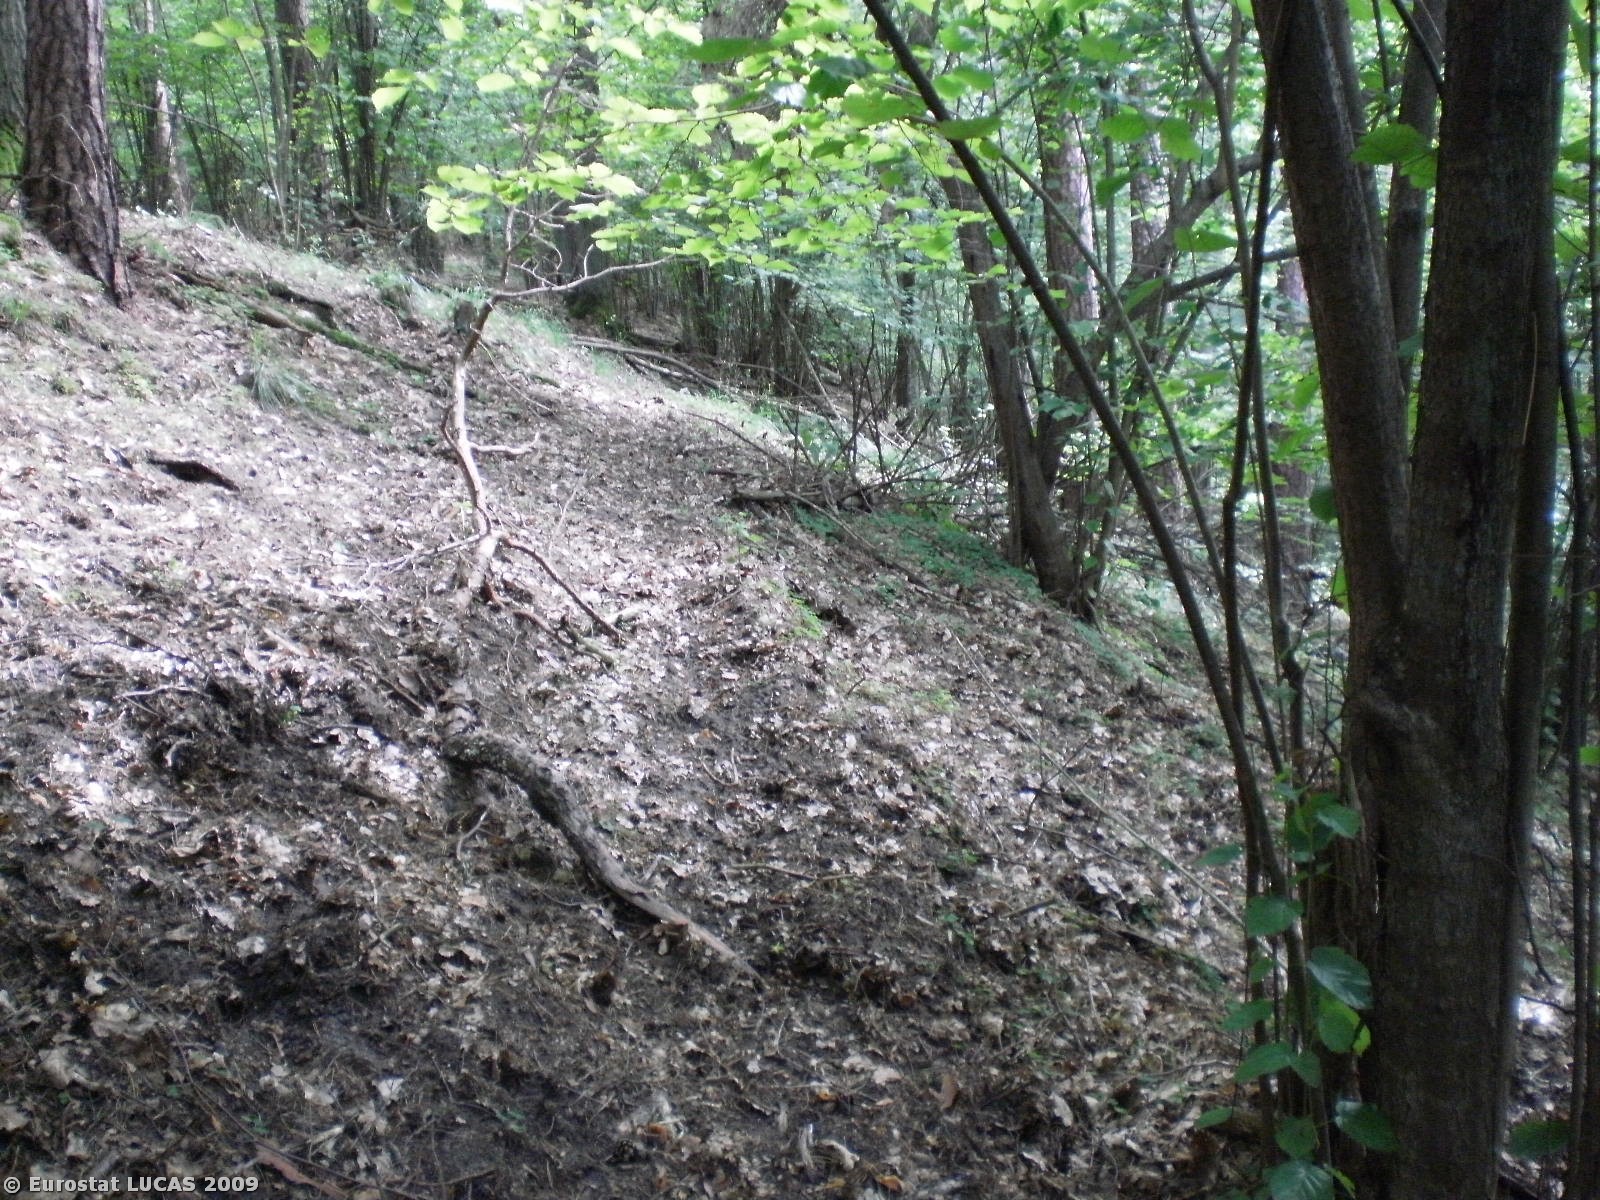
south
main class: Woodland
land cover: Mixed woodland
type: hemiboreal forest and nemoral coniferous forest and mixed broadleaved-coniferous forest
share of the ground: > 75 %
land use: Forestry
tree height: > 5 m
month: July
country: PL
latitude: 53.5608
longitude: 20.4994
